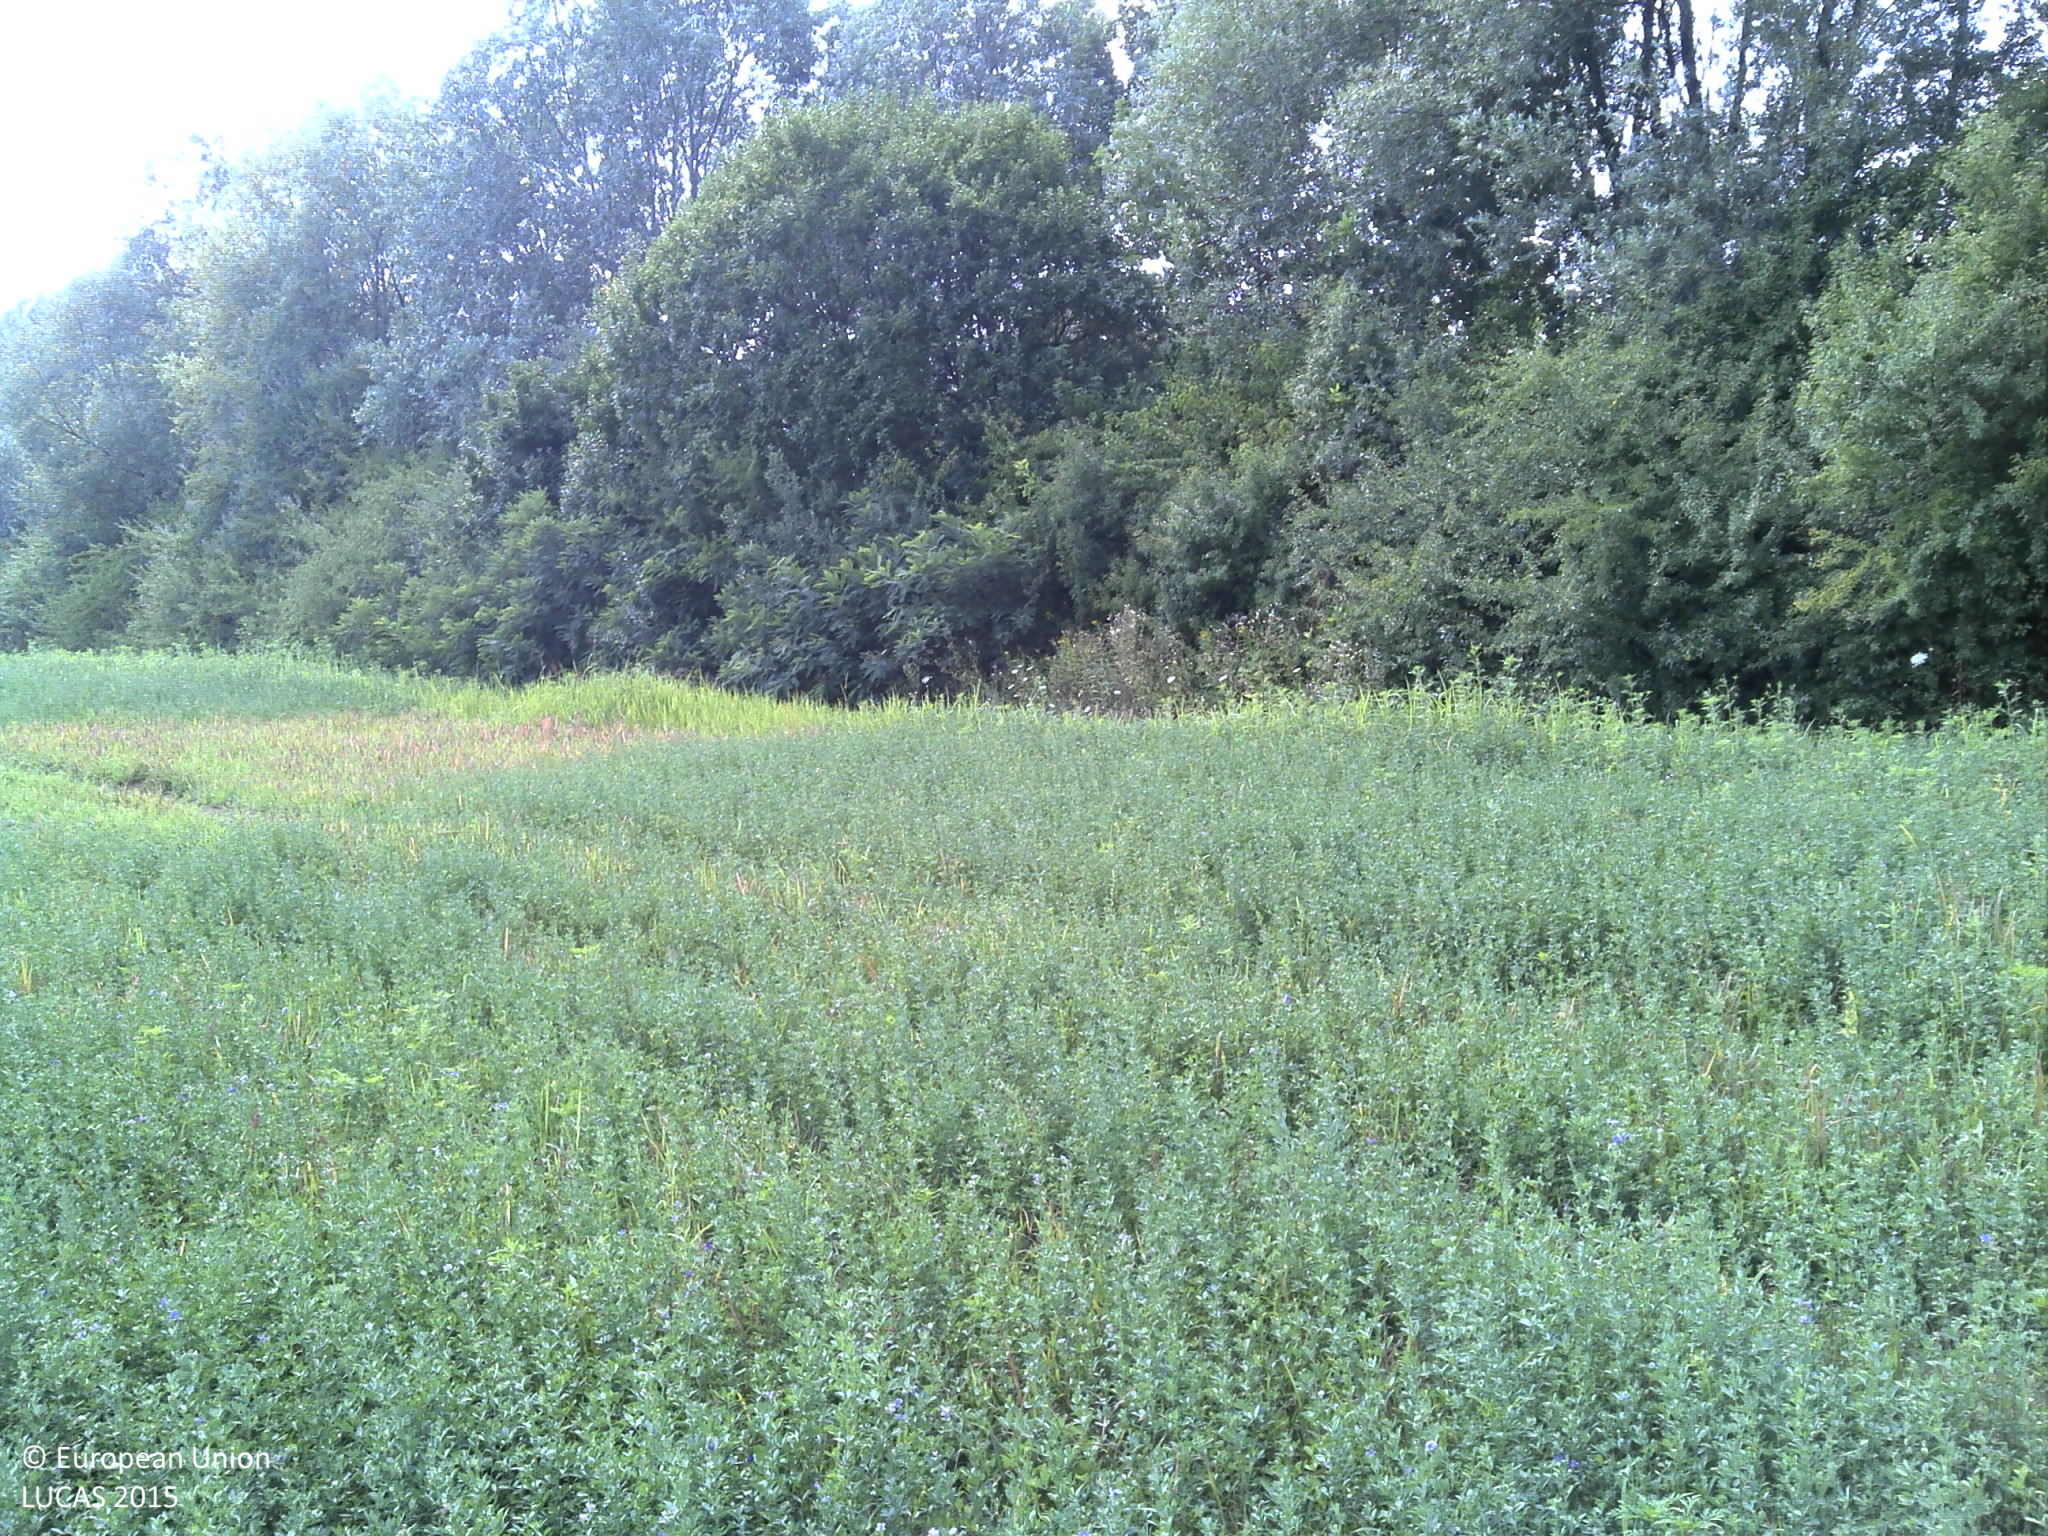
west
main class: Cropland
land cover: Clovers
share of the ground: > 75 %
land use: Agriculture (excluding fallow land and kitchen gardens)
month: August
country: HR
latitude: 45.4857
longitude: 16.4849
